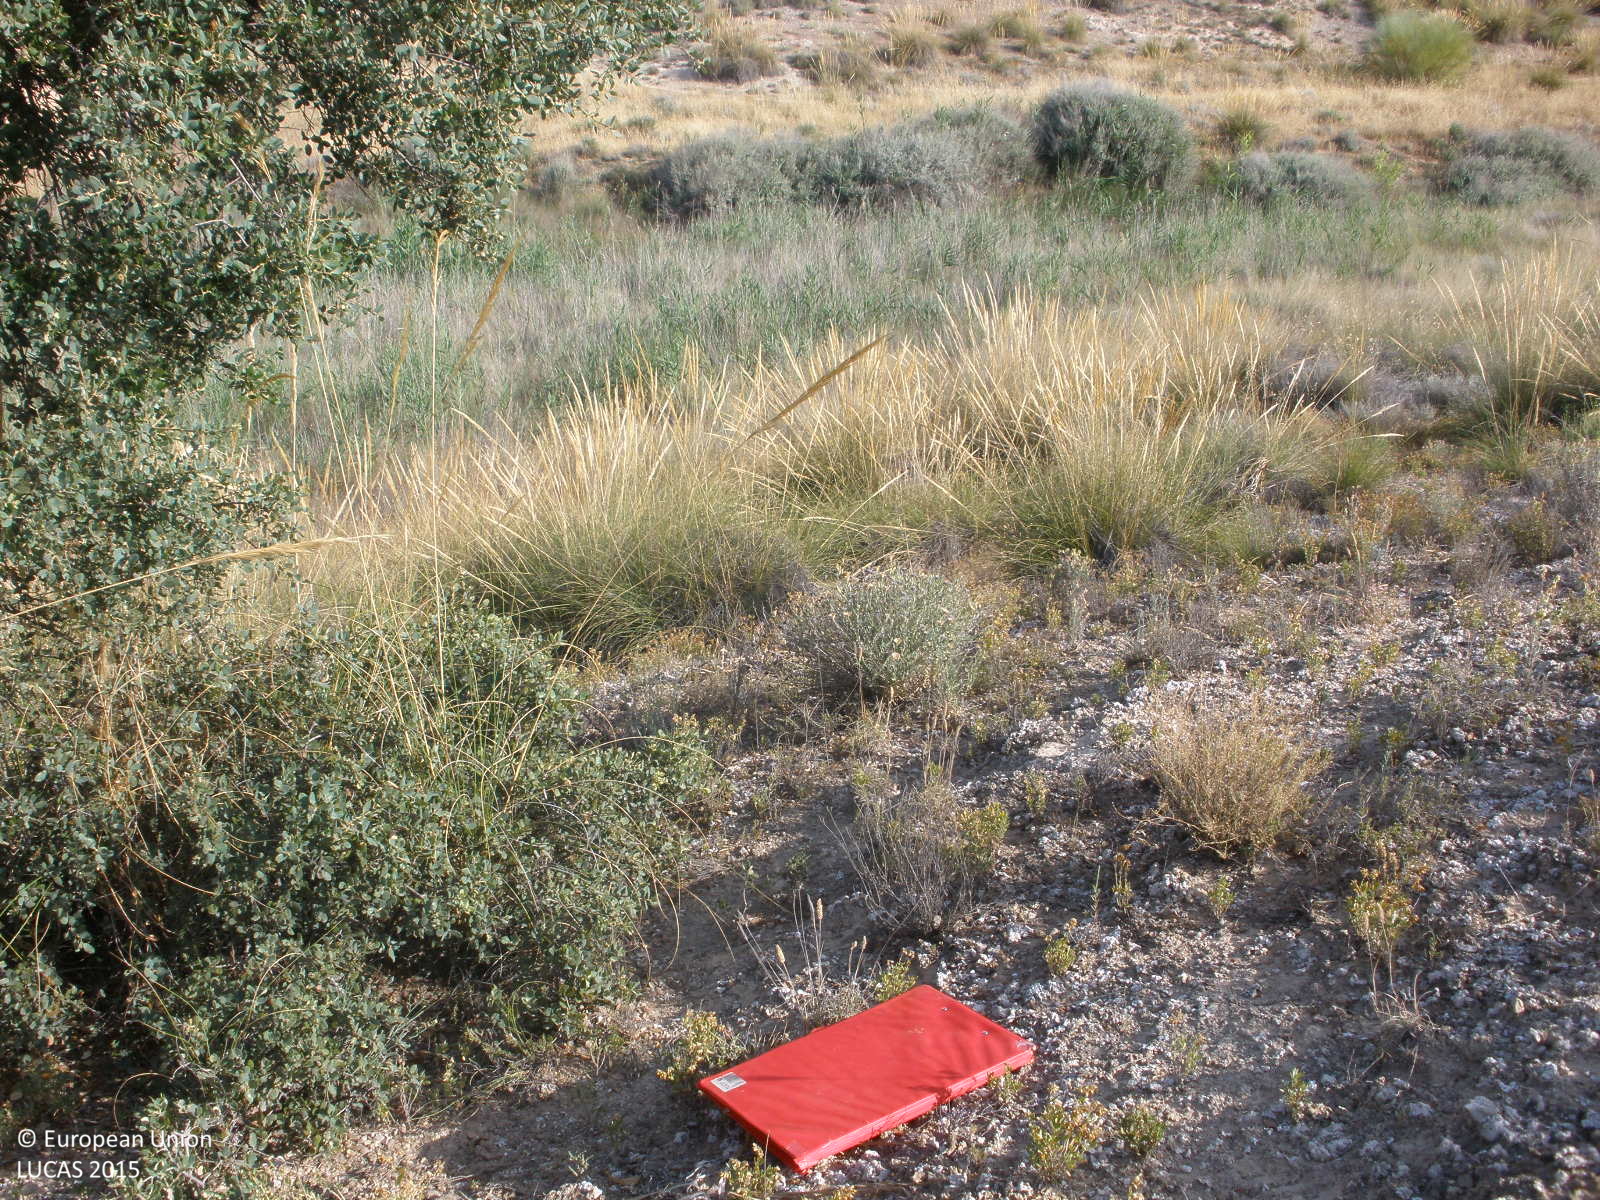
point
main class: Shrubland
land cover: Shrubland with sparse tree cover
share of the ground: 50 - 75 %
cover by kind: shrubs 45 %, herbaceous plants 35 %, consolidated bare surface 15 %, broadleaved forest trees 5 %
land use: Semi-natural and natural areas not in use
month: July
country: ES
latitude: 40.0570
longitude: -3.4050
